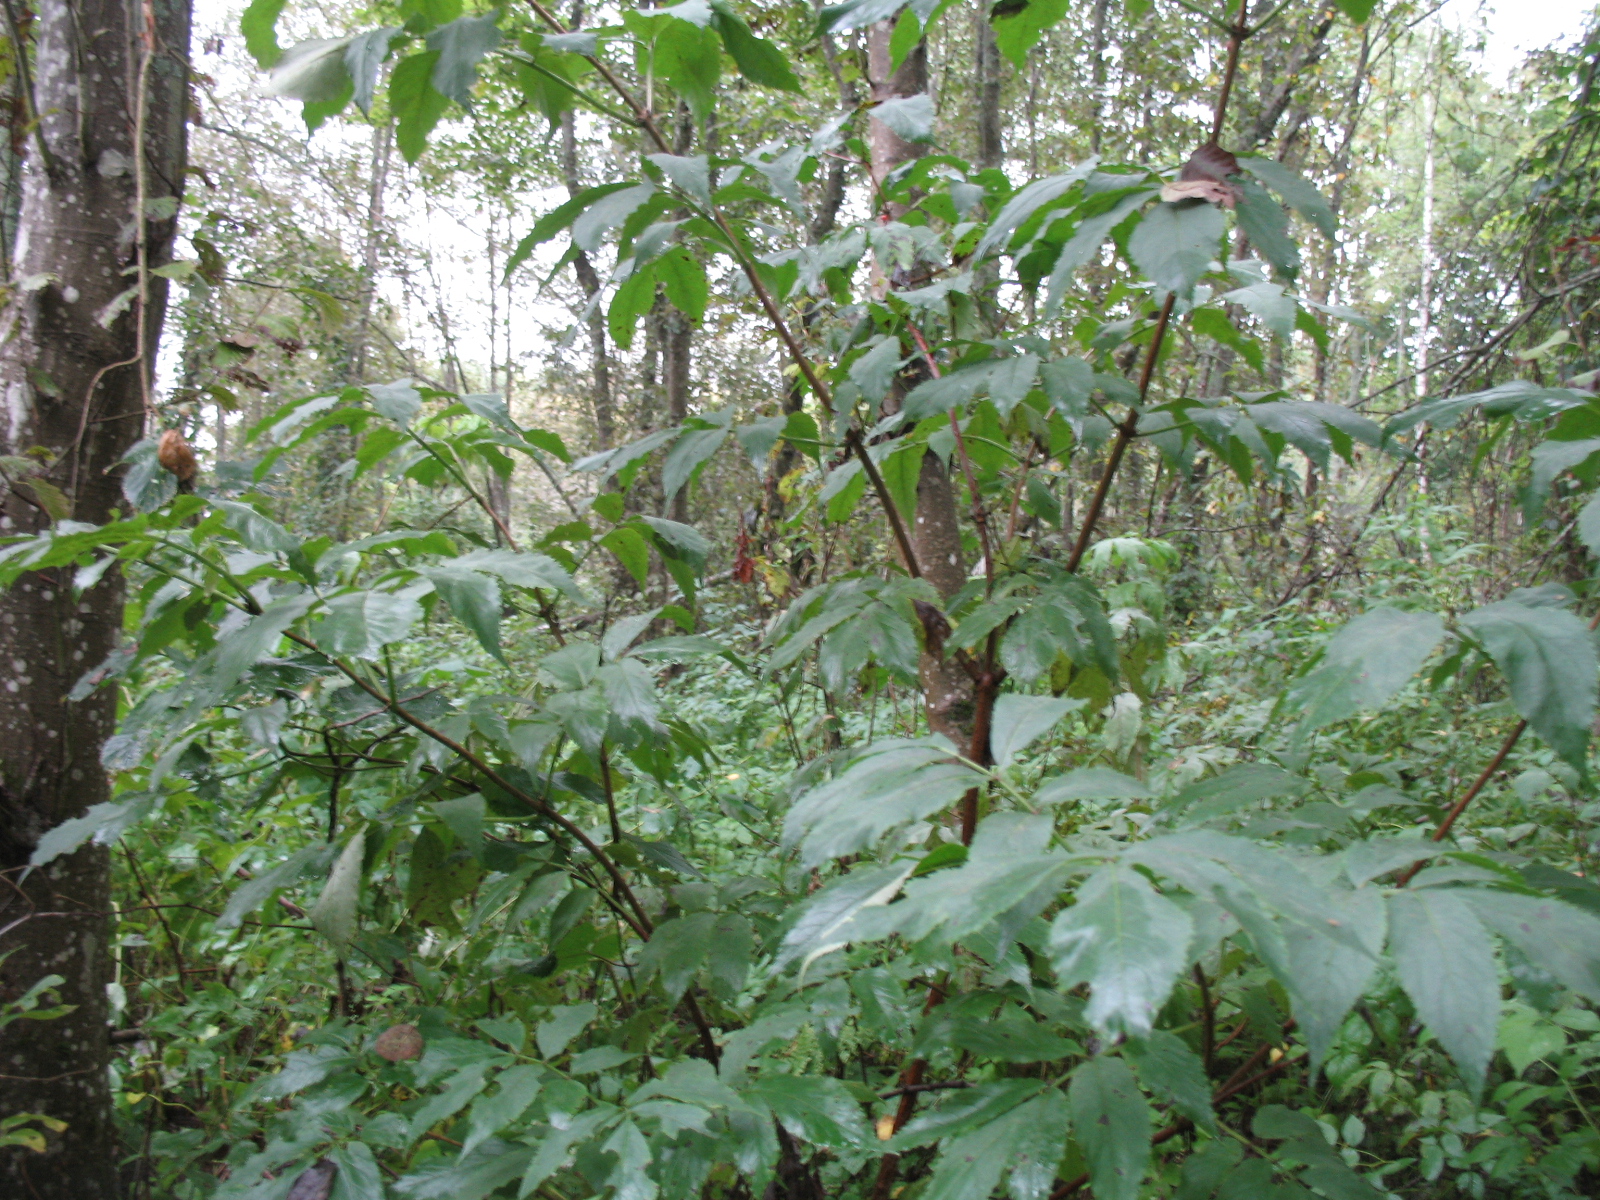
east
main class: Woodland
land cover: Broadleaved woodland
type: non-riverine alder, birch or aspen forest
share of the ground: > 75 %
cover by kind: broadleaved forest trees 75 %, shrubs 20 %, herbaceous plants 5 %
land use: Forestry
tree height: > 5 m
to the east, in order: Broadleaved woodland; Spontaneously vegetated surfaces; Electric lines; Spontaneously vegetated surfaces; Broadleaved woodland; Ditches and canals; Broadleaved woodland
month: September
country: LV
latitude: 56.0903
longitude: 26.1641
